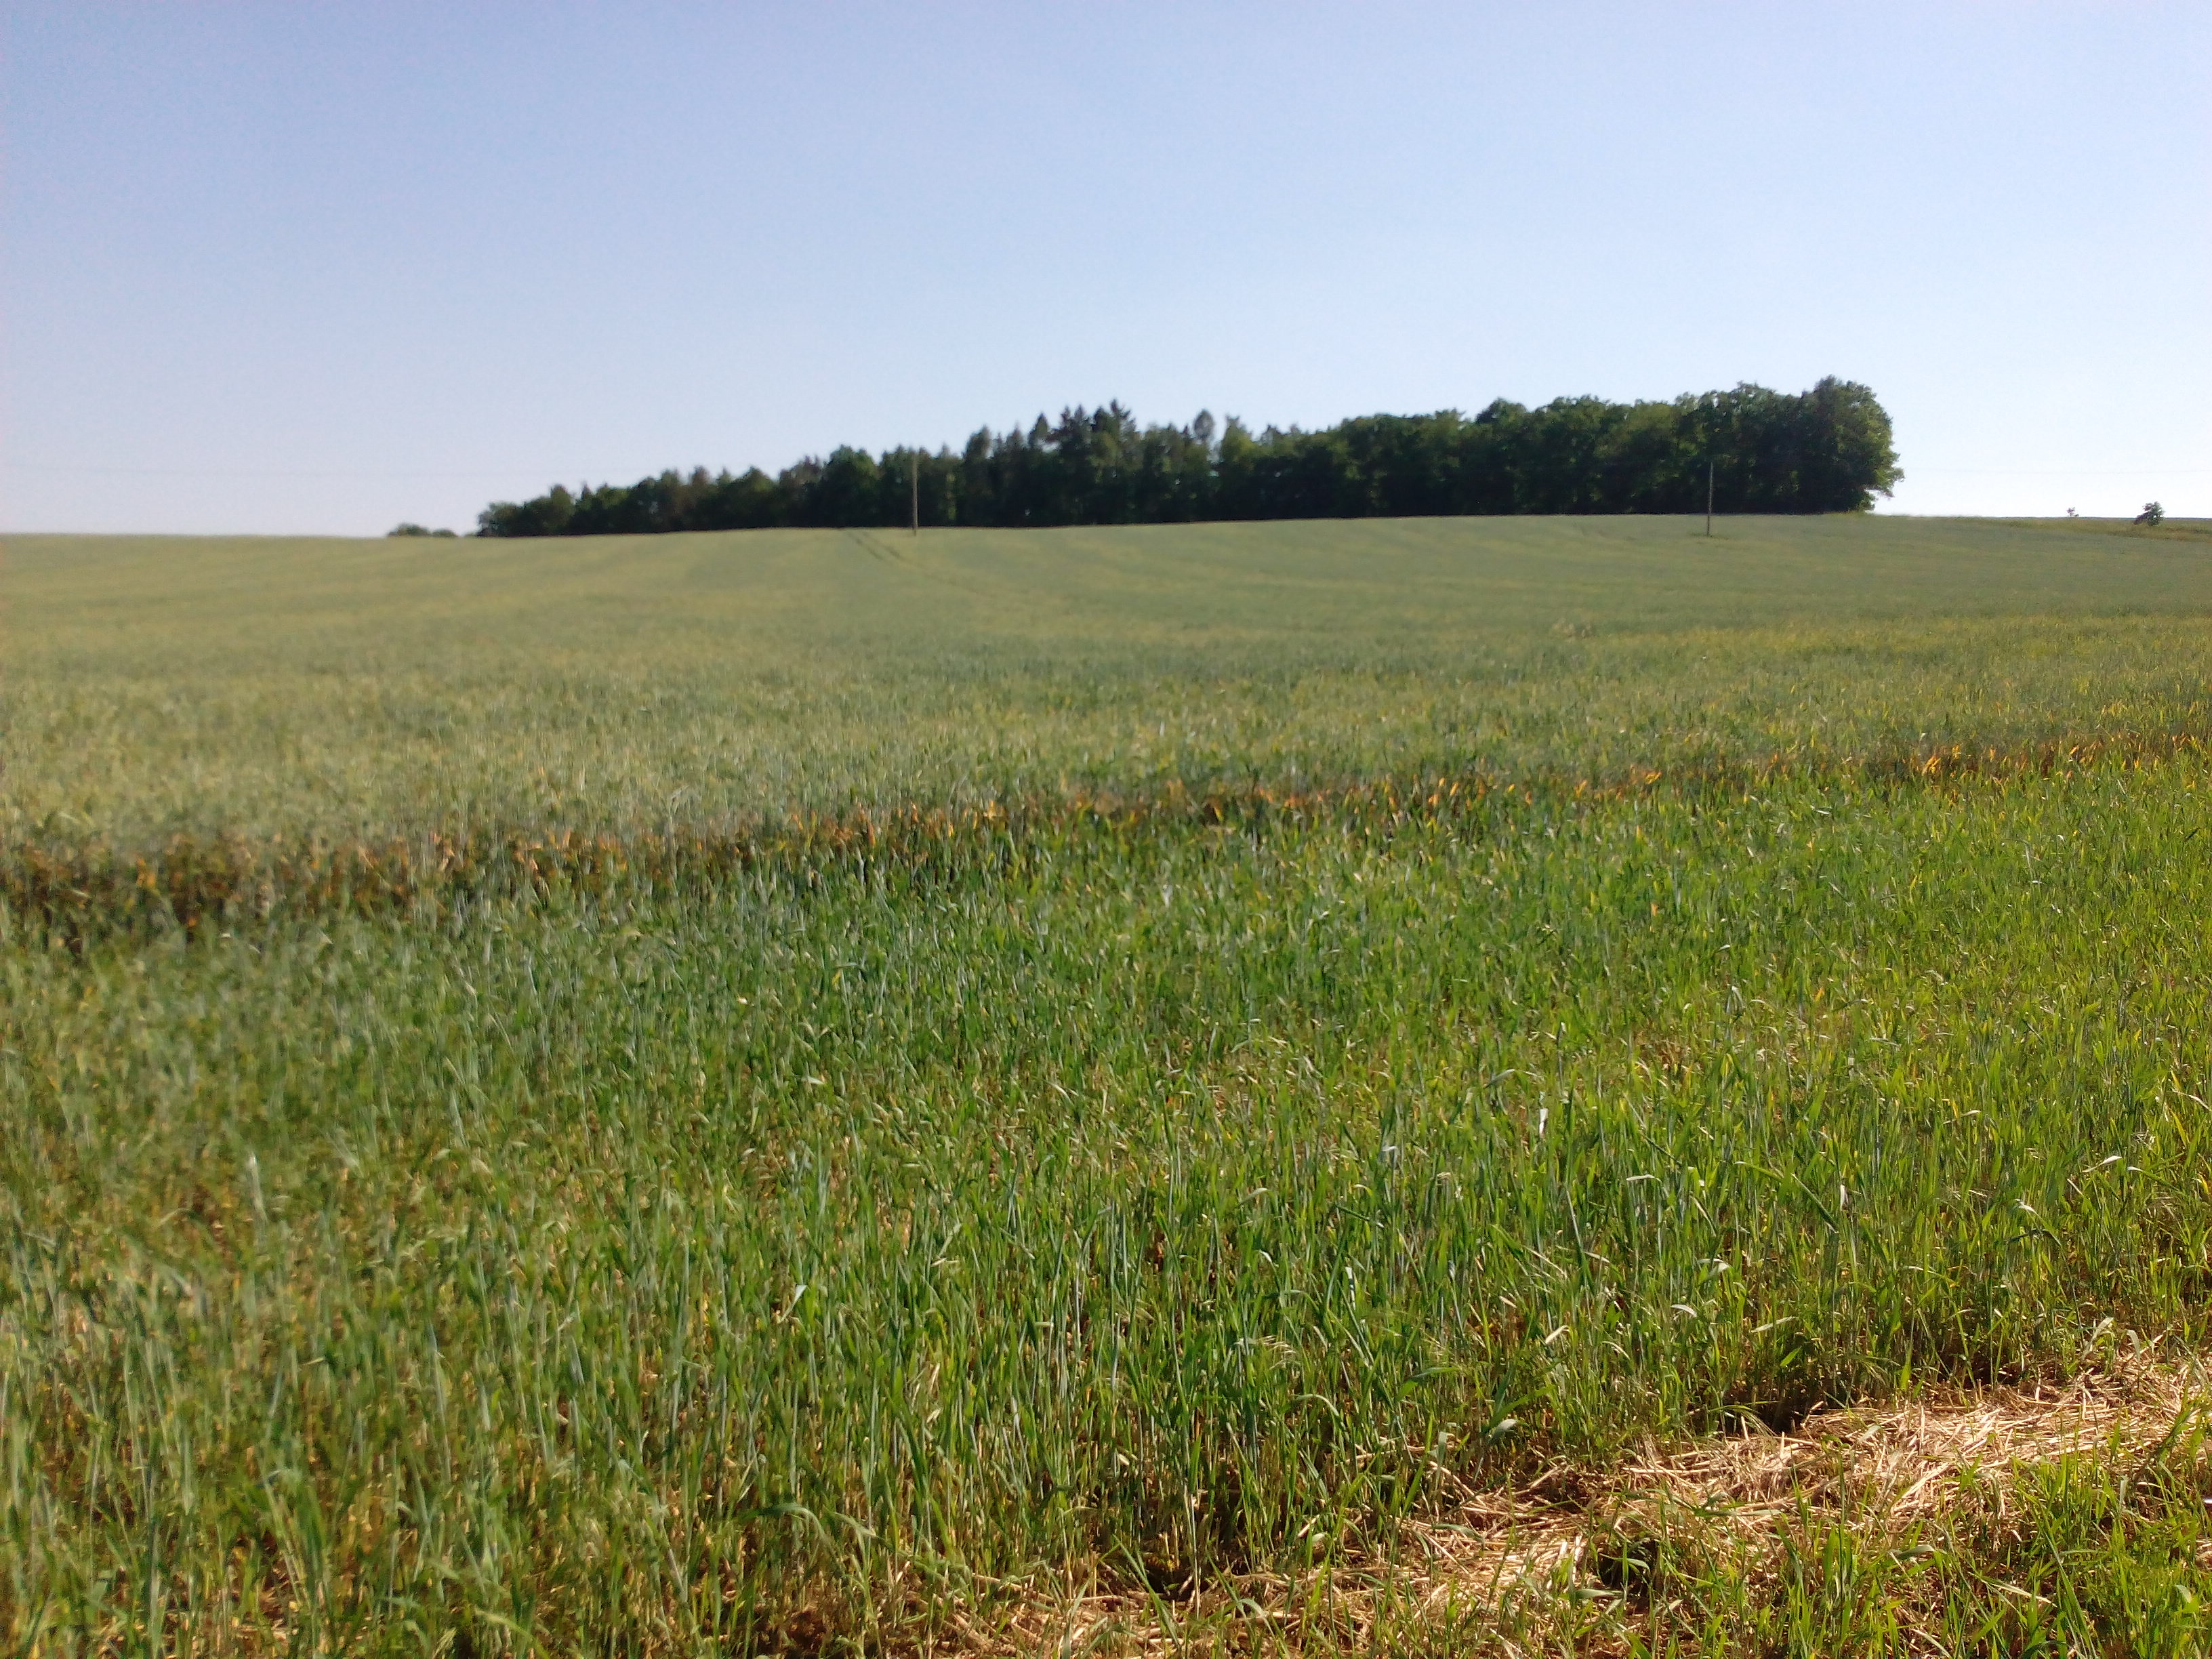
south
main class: Cropland
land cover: Common wheat
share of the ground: > 75 %
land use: Agriculture (excluding fallow land and kitchen gardens)
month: June
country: DE
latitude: 50.3803
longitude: 10.6326
